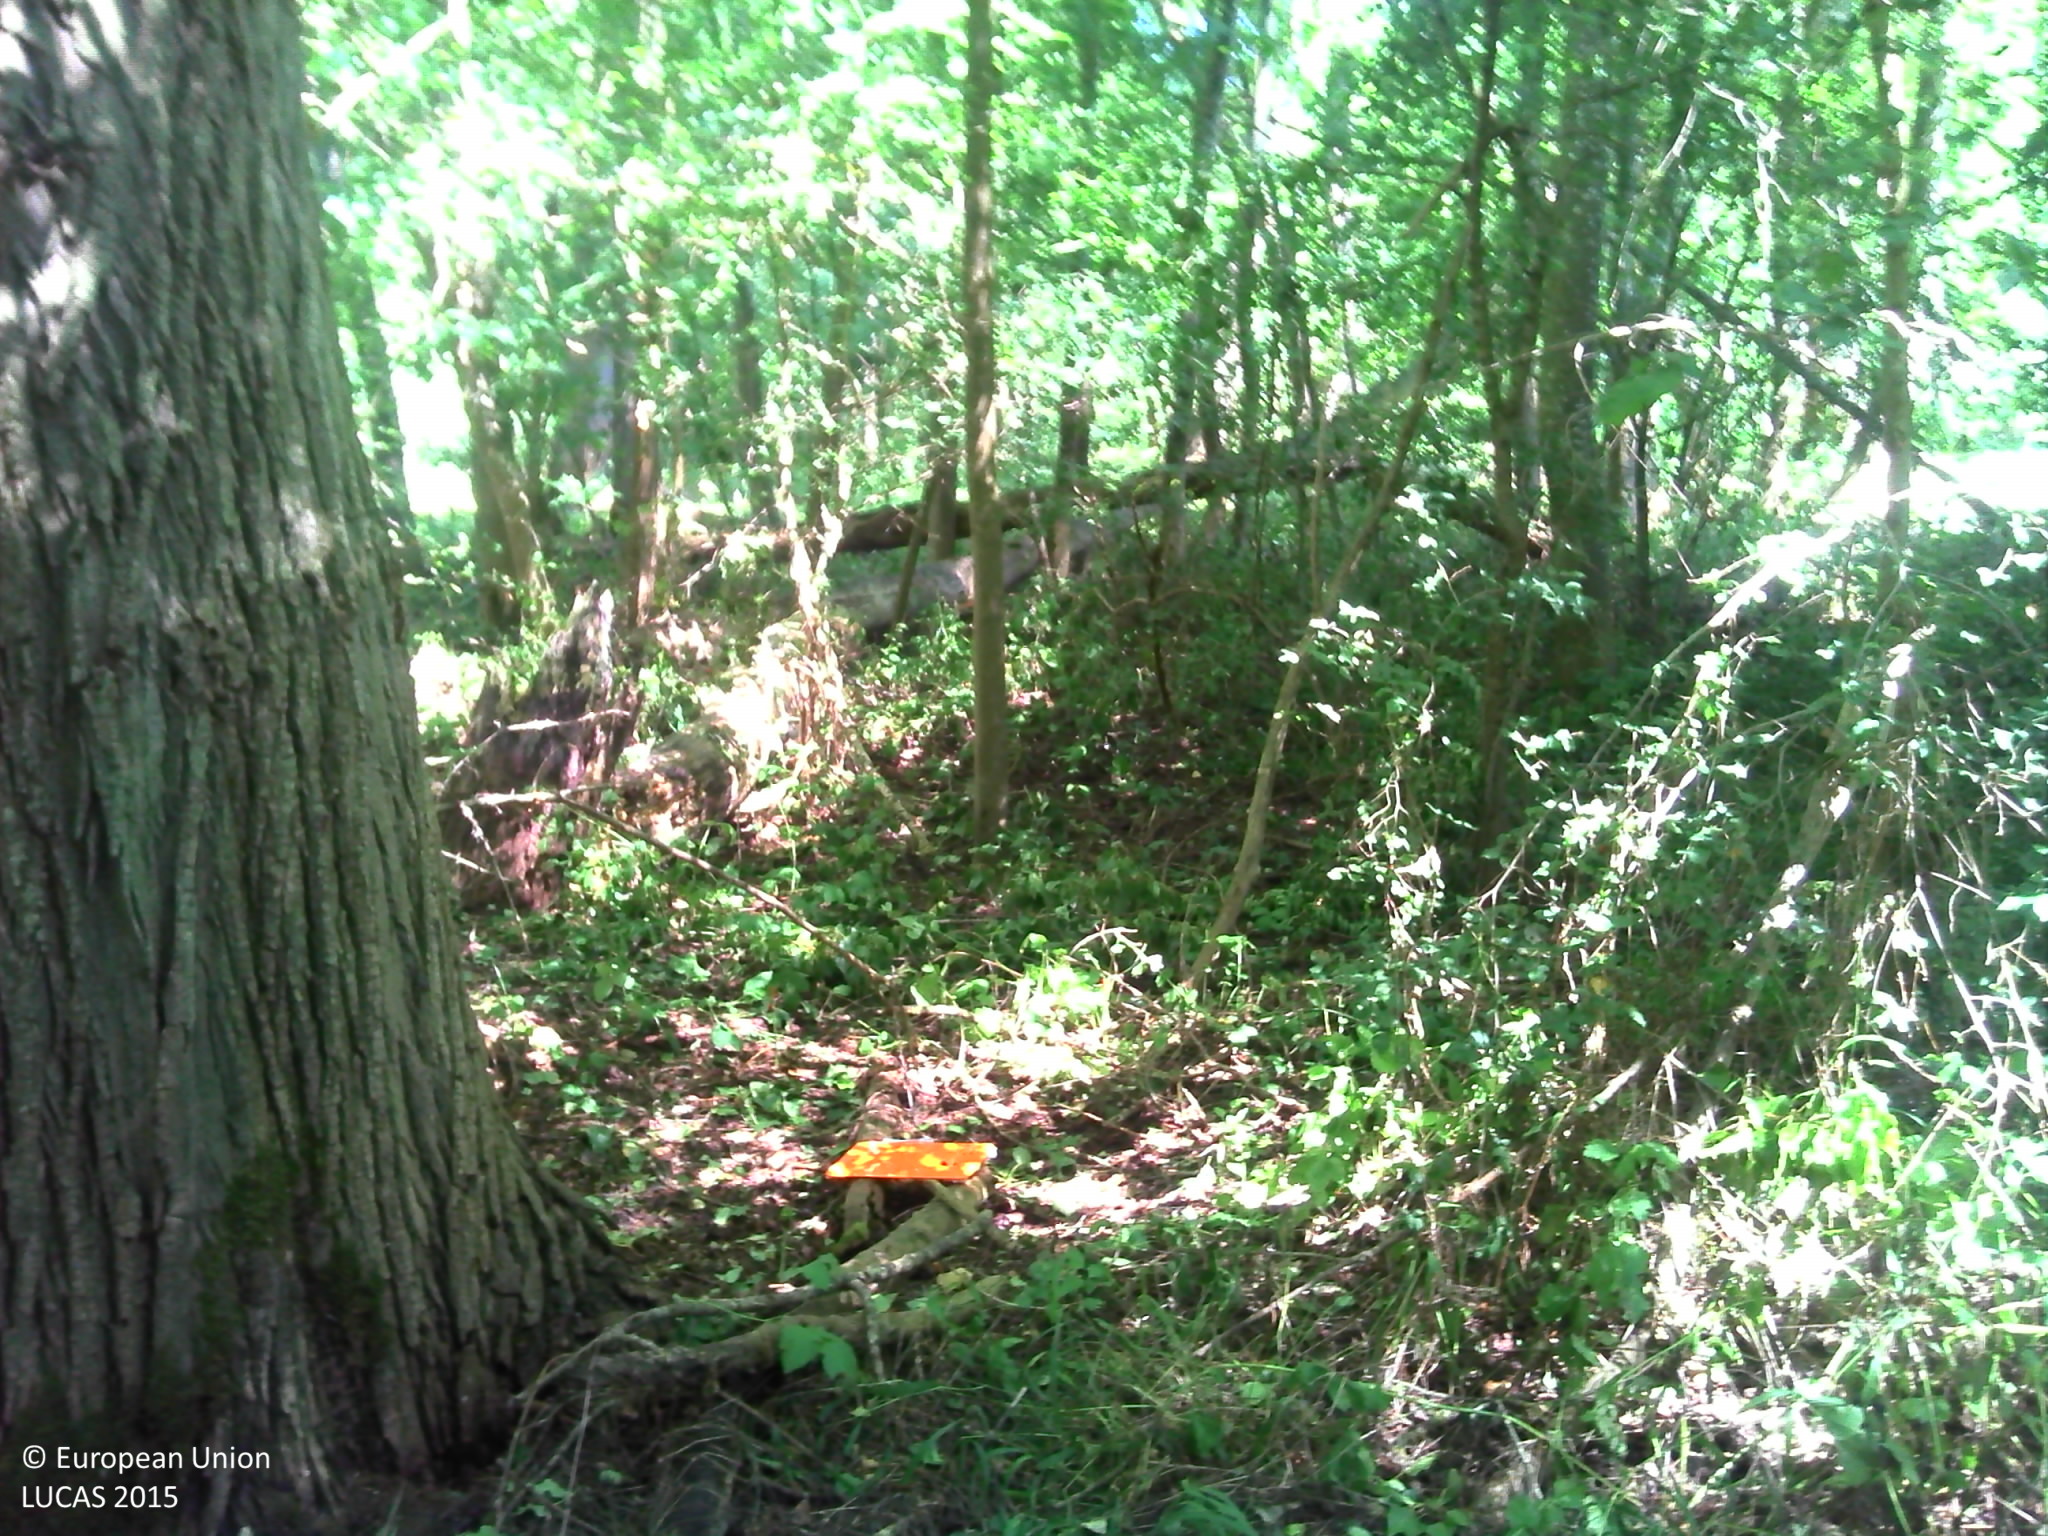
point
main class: Woodland
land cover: Broadleaved woodland
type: floodplain forest
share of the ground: > 75 %
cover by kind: broadleaved forest trees 100 %
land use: Forestry
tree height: > 5 m
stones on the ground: < 10 %
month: July
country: FR
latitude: 45.3506
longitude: 3.3775
